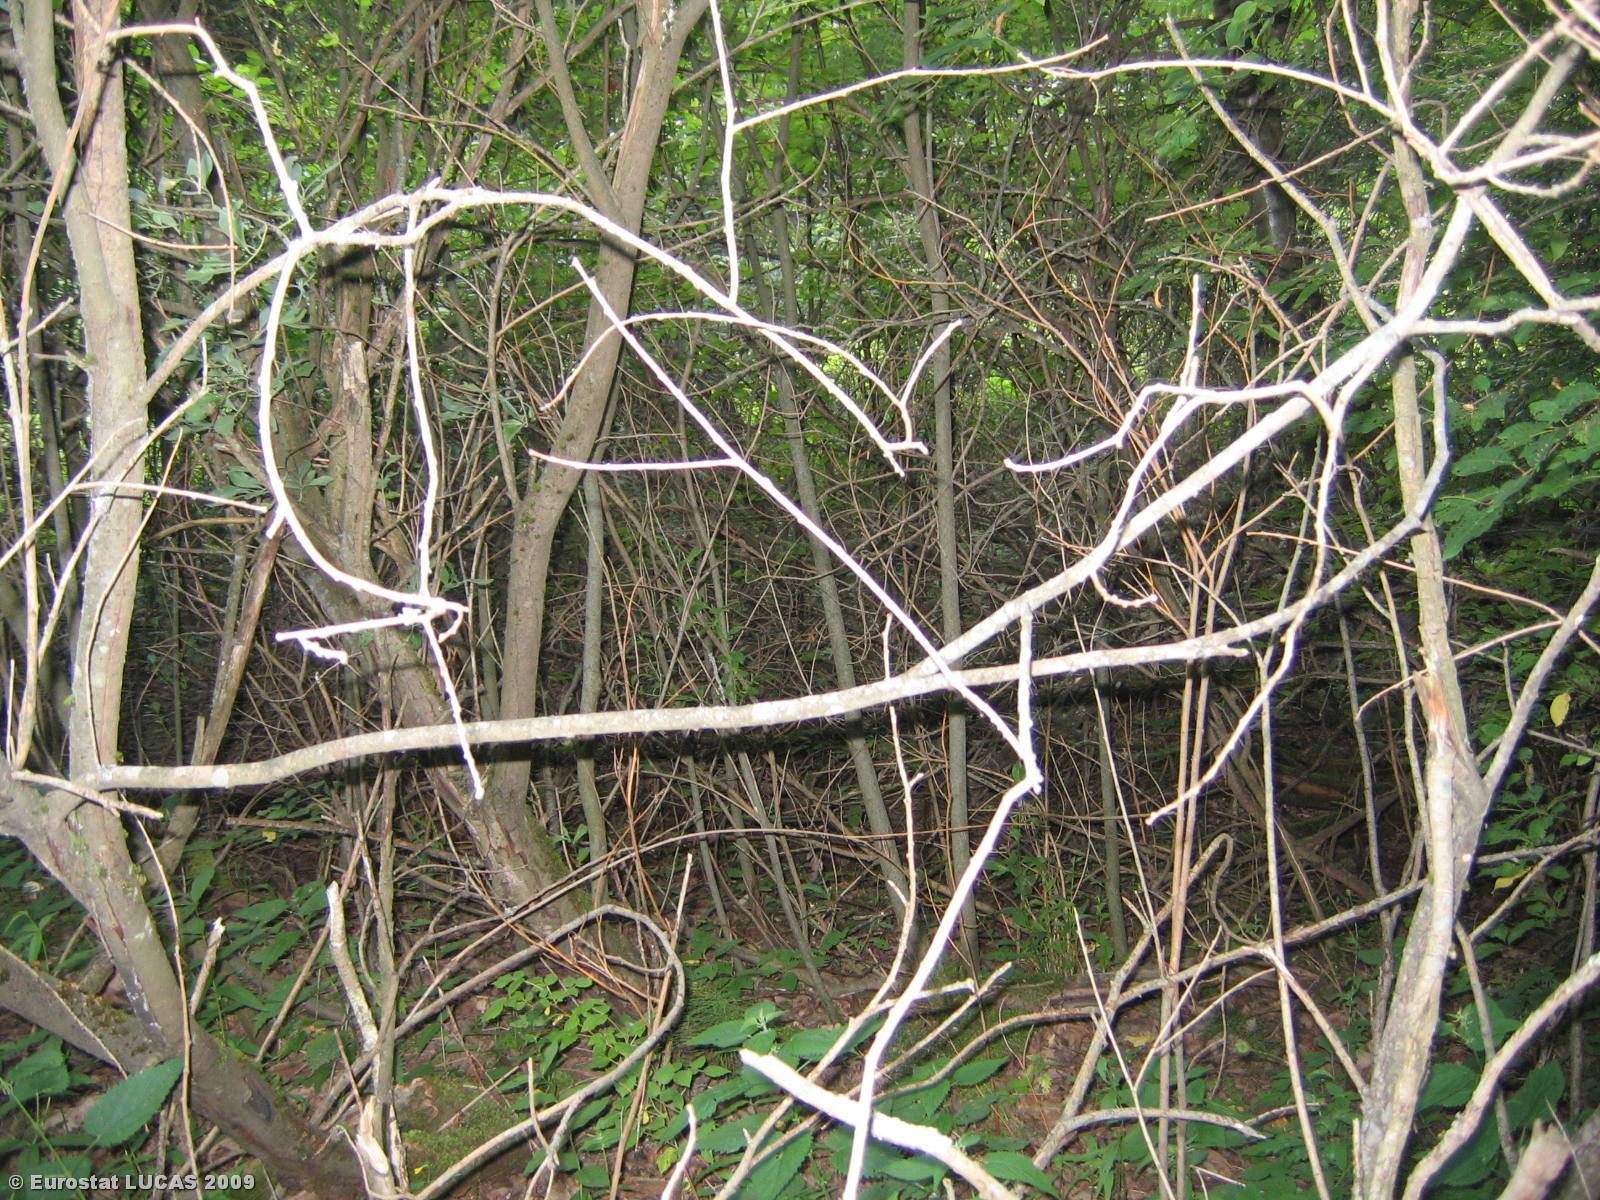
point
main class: Woodland
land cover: Broadleaved woodland
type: non-riverine alder, birch or aspen forest
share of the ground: > 75 %
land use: Forestry
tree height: > 5 m
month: July
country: LT
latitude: 55.4238
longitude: 22.7209
